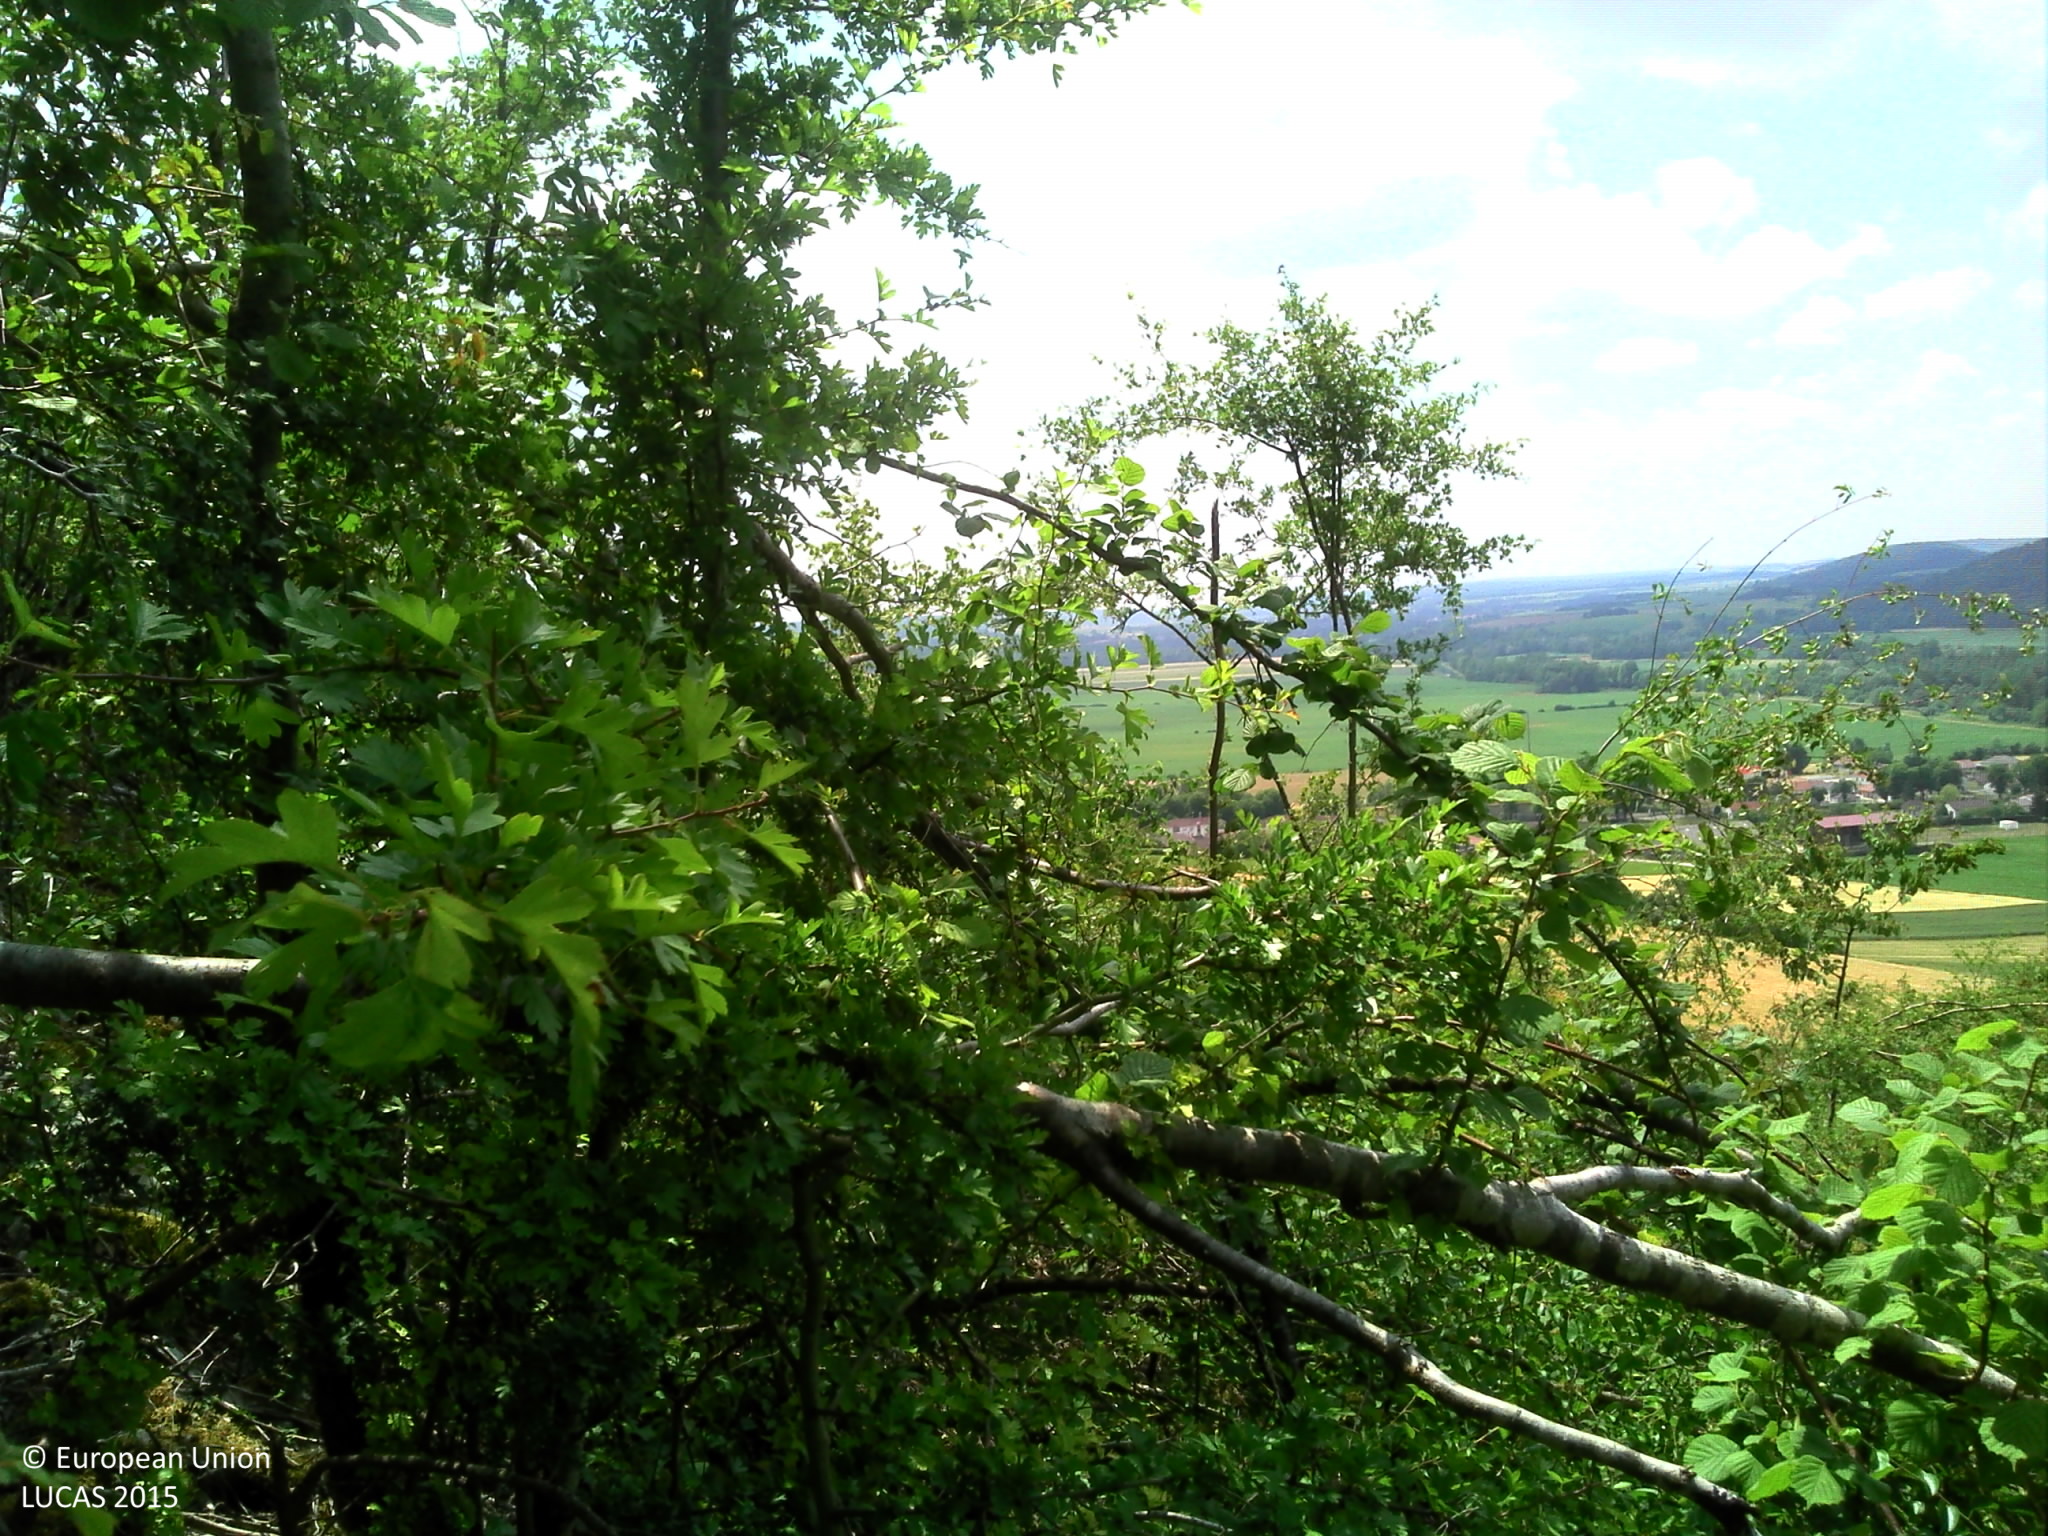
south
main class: Woodland
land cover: Broadleaved woodland
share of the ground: > 75 %
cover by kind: broadleaved forest trees 80 %, coniferous forest trees 10 %, herbaceous plants 5 %, lichens and mosses 5 %
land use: Forestry
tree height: < 5 m
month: June
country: FR
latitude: 48.4064
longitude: 5.1762
